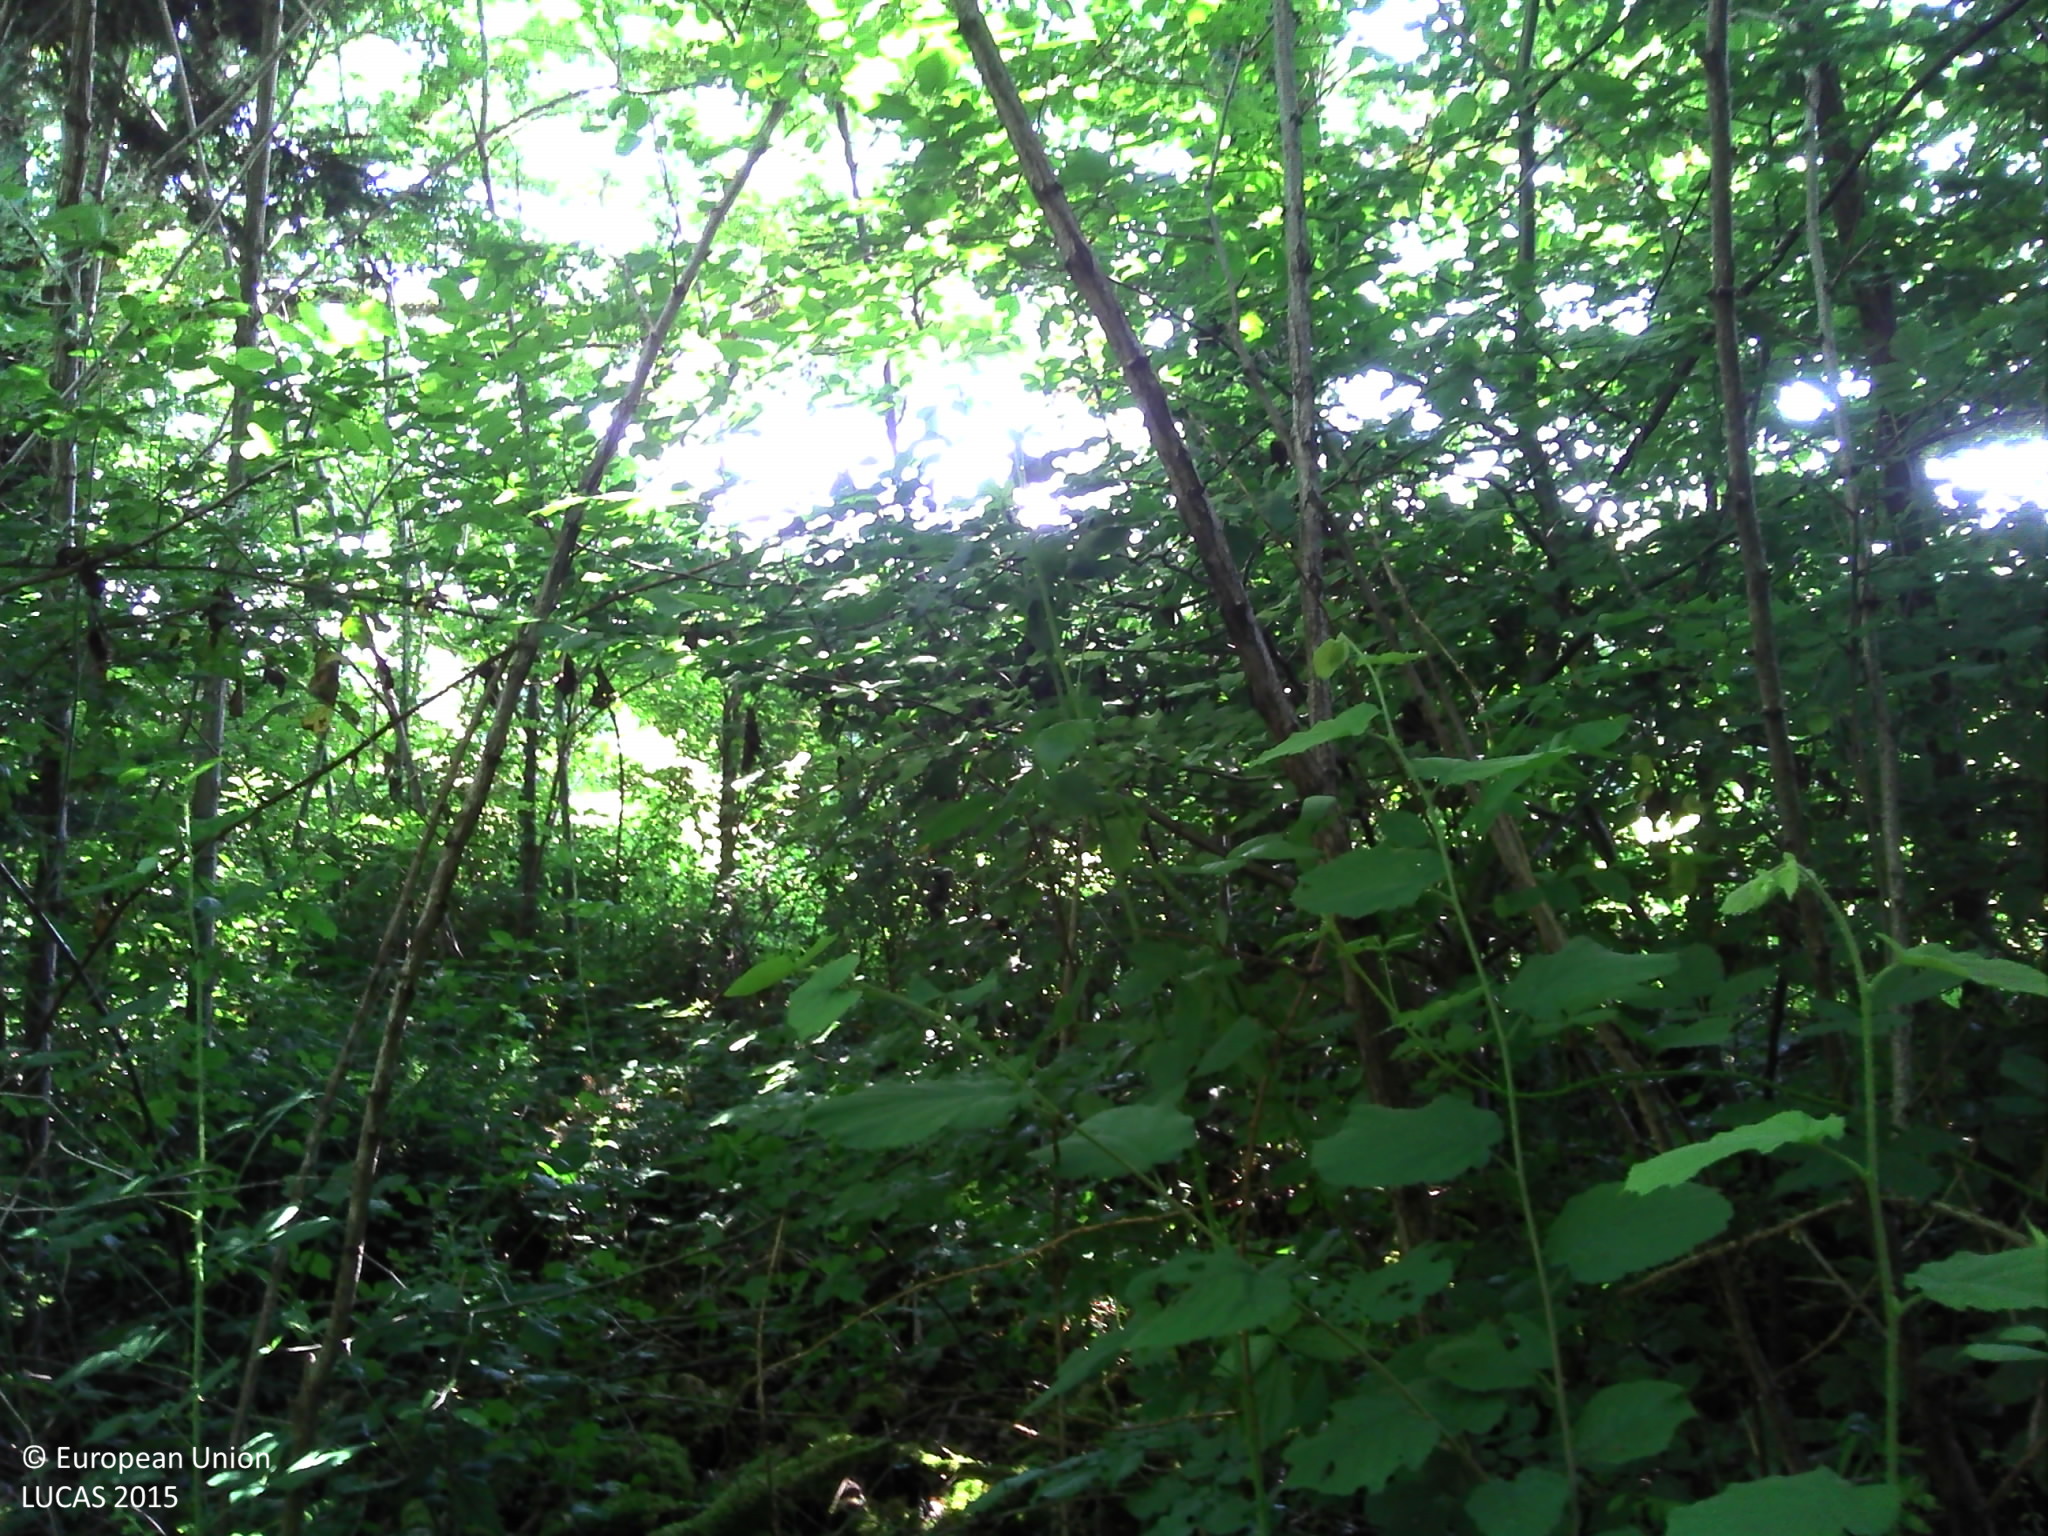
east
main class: Woodland
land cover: Other mixed woodland
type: mesophytic deciduous forest
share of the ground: > 75 %
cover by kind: broadleaved forest trees 75 %, coniferous forest trees 25 %
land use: Semi-natural and natural areas not in use
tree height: > 5 m
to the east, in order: Other mixed woodland; Maize; Broadleaved woodland; Maize
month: June
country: FR
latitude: 45.8502
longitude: 0.6502
